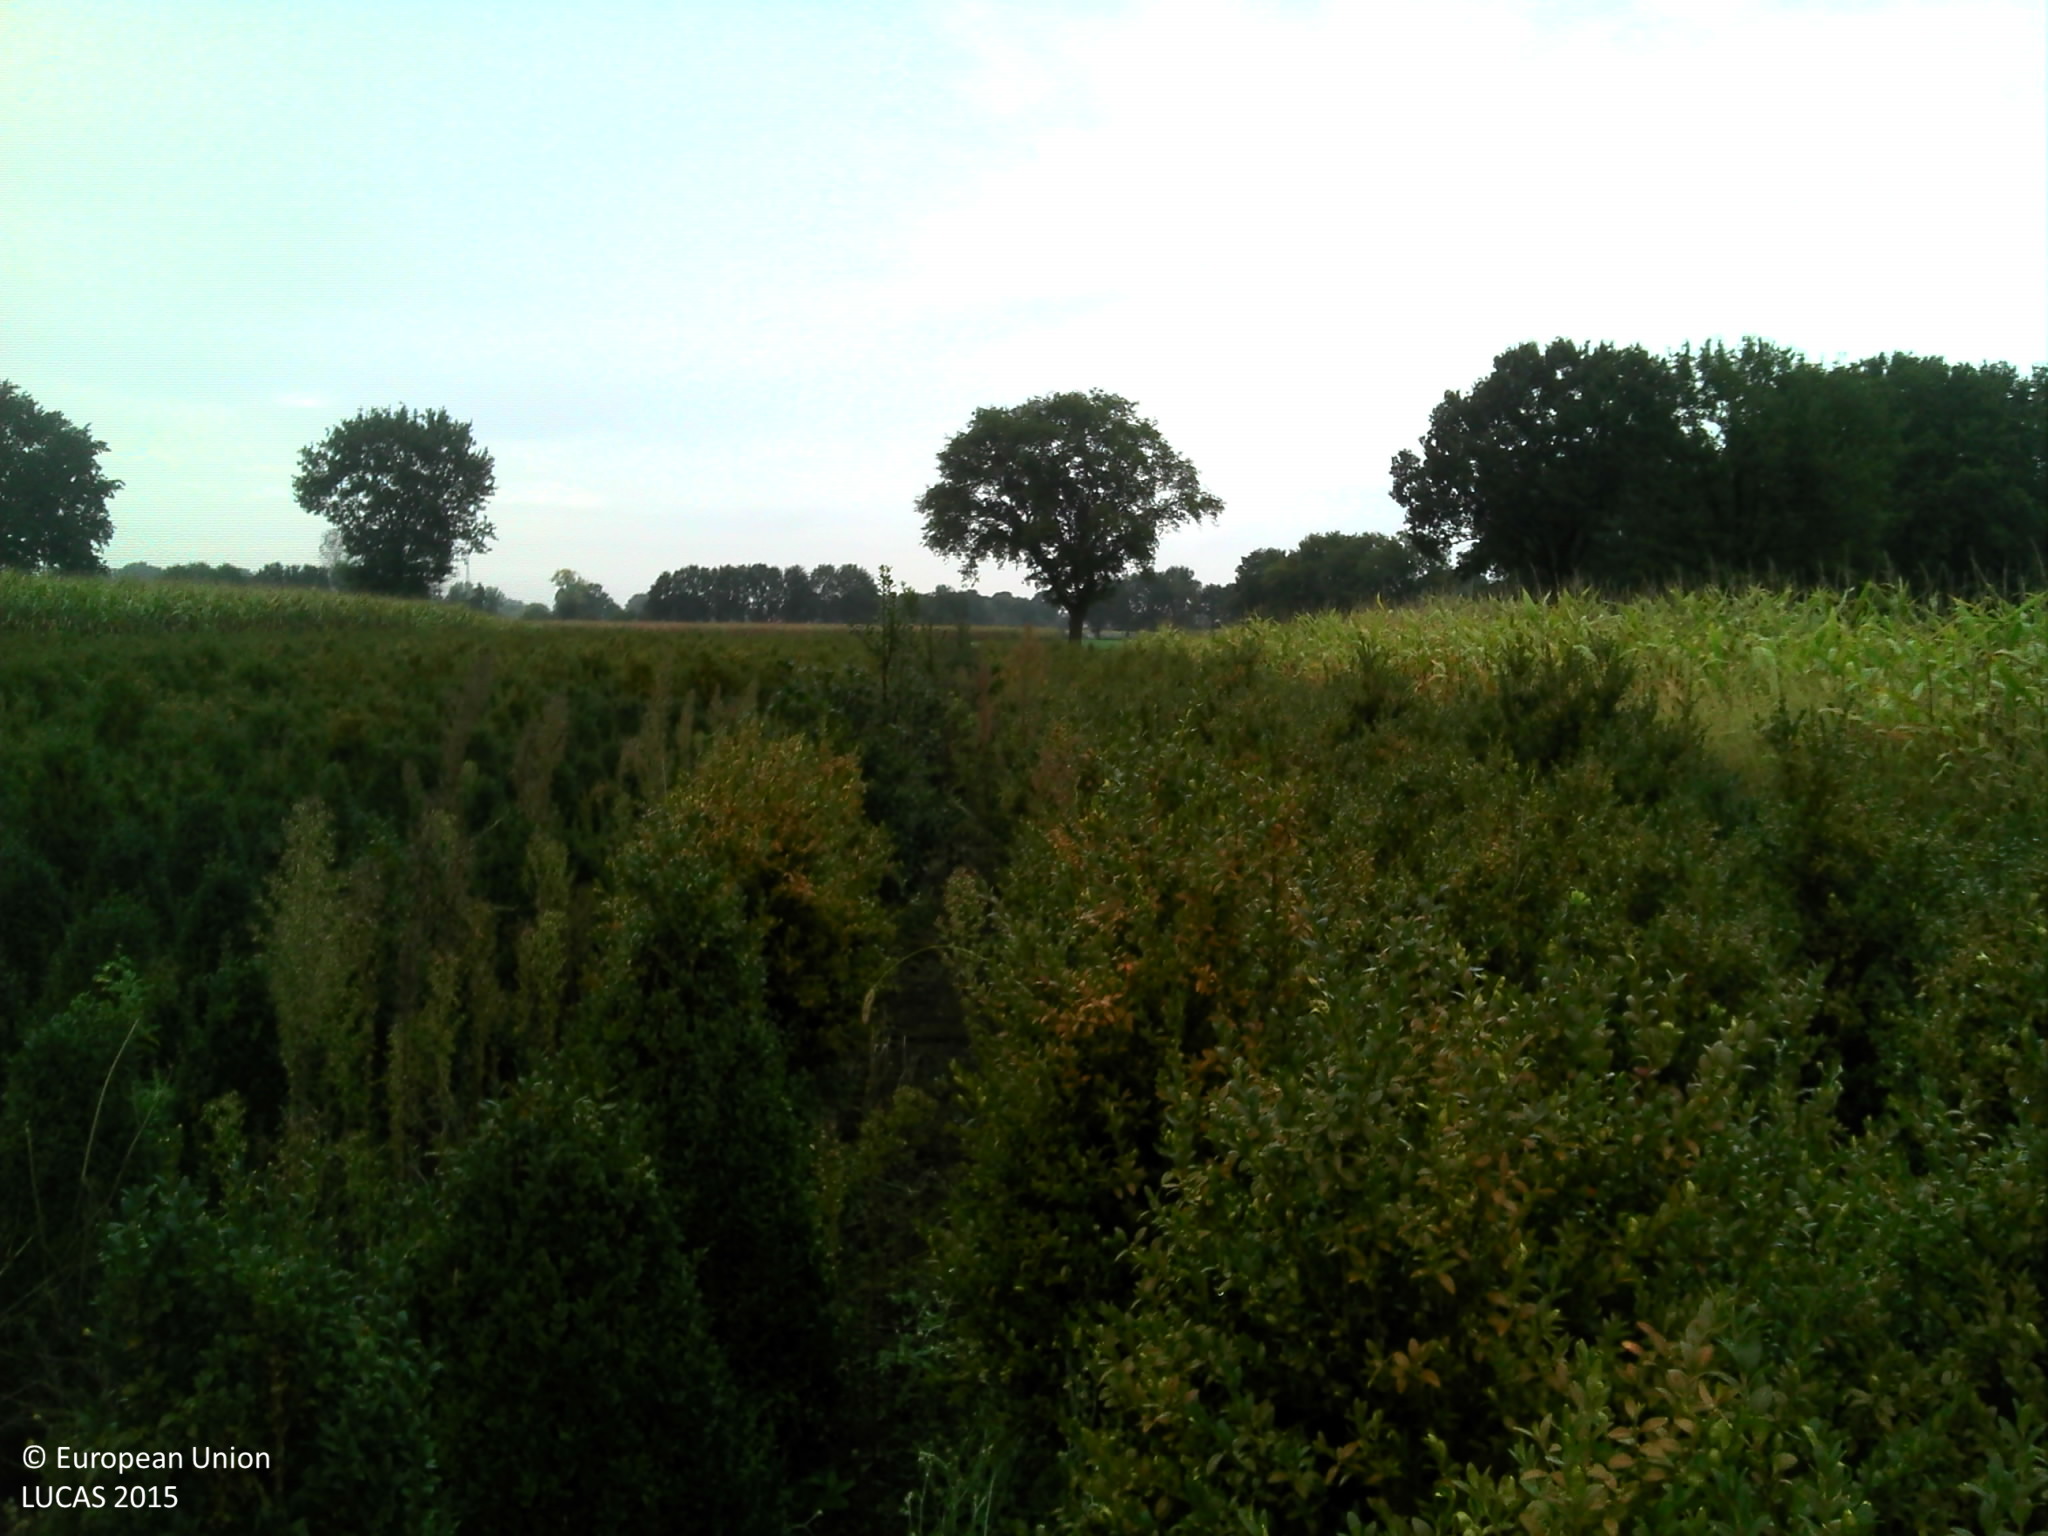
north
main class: Cropland
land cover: Nurseries
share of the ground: > 75 %
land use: Agriculture (excluding fallow land and kitchen gardens)
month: October
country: BE
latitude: 51.1099
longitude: 4.7830
